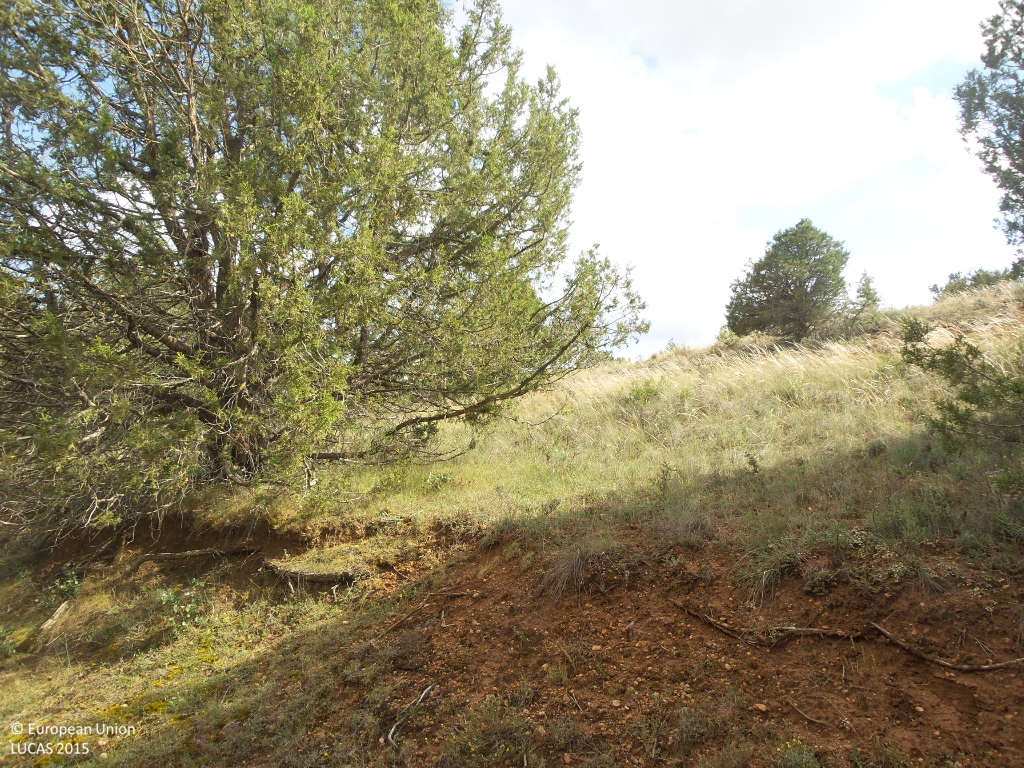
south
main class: Woodland
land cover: Other coniferous woodland
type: coniferous forest of the mediterranean region
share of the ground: 50 - 75 %
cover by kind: coniferous forest trees 50 %, herbaceous plants 30 %, shrubs 10 %, unconsolidated bare surface 10 %
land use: Forestry
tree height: > 5 m
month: June
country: ES
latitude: 41.4778
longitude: -3.1805
